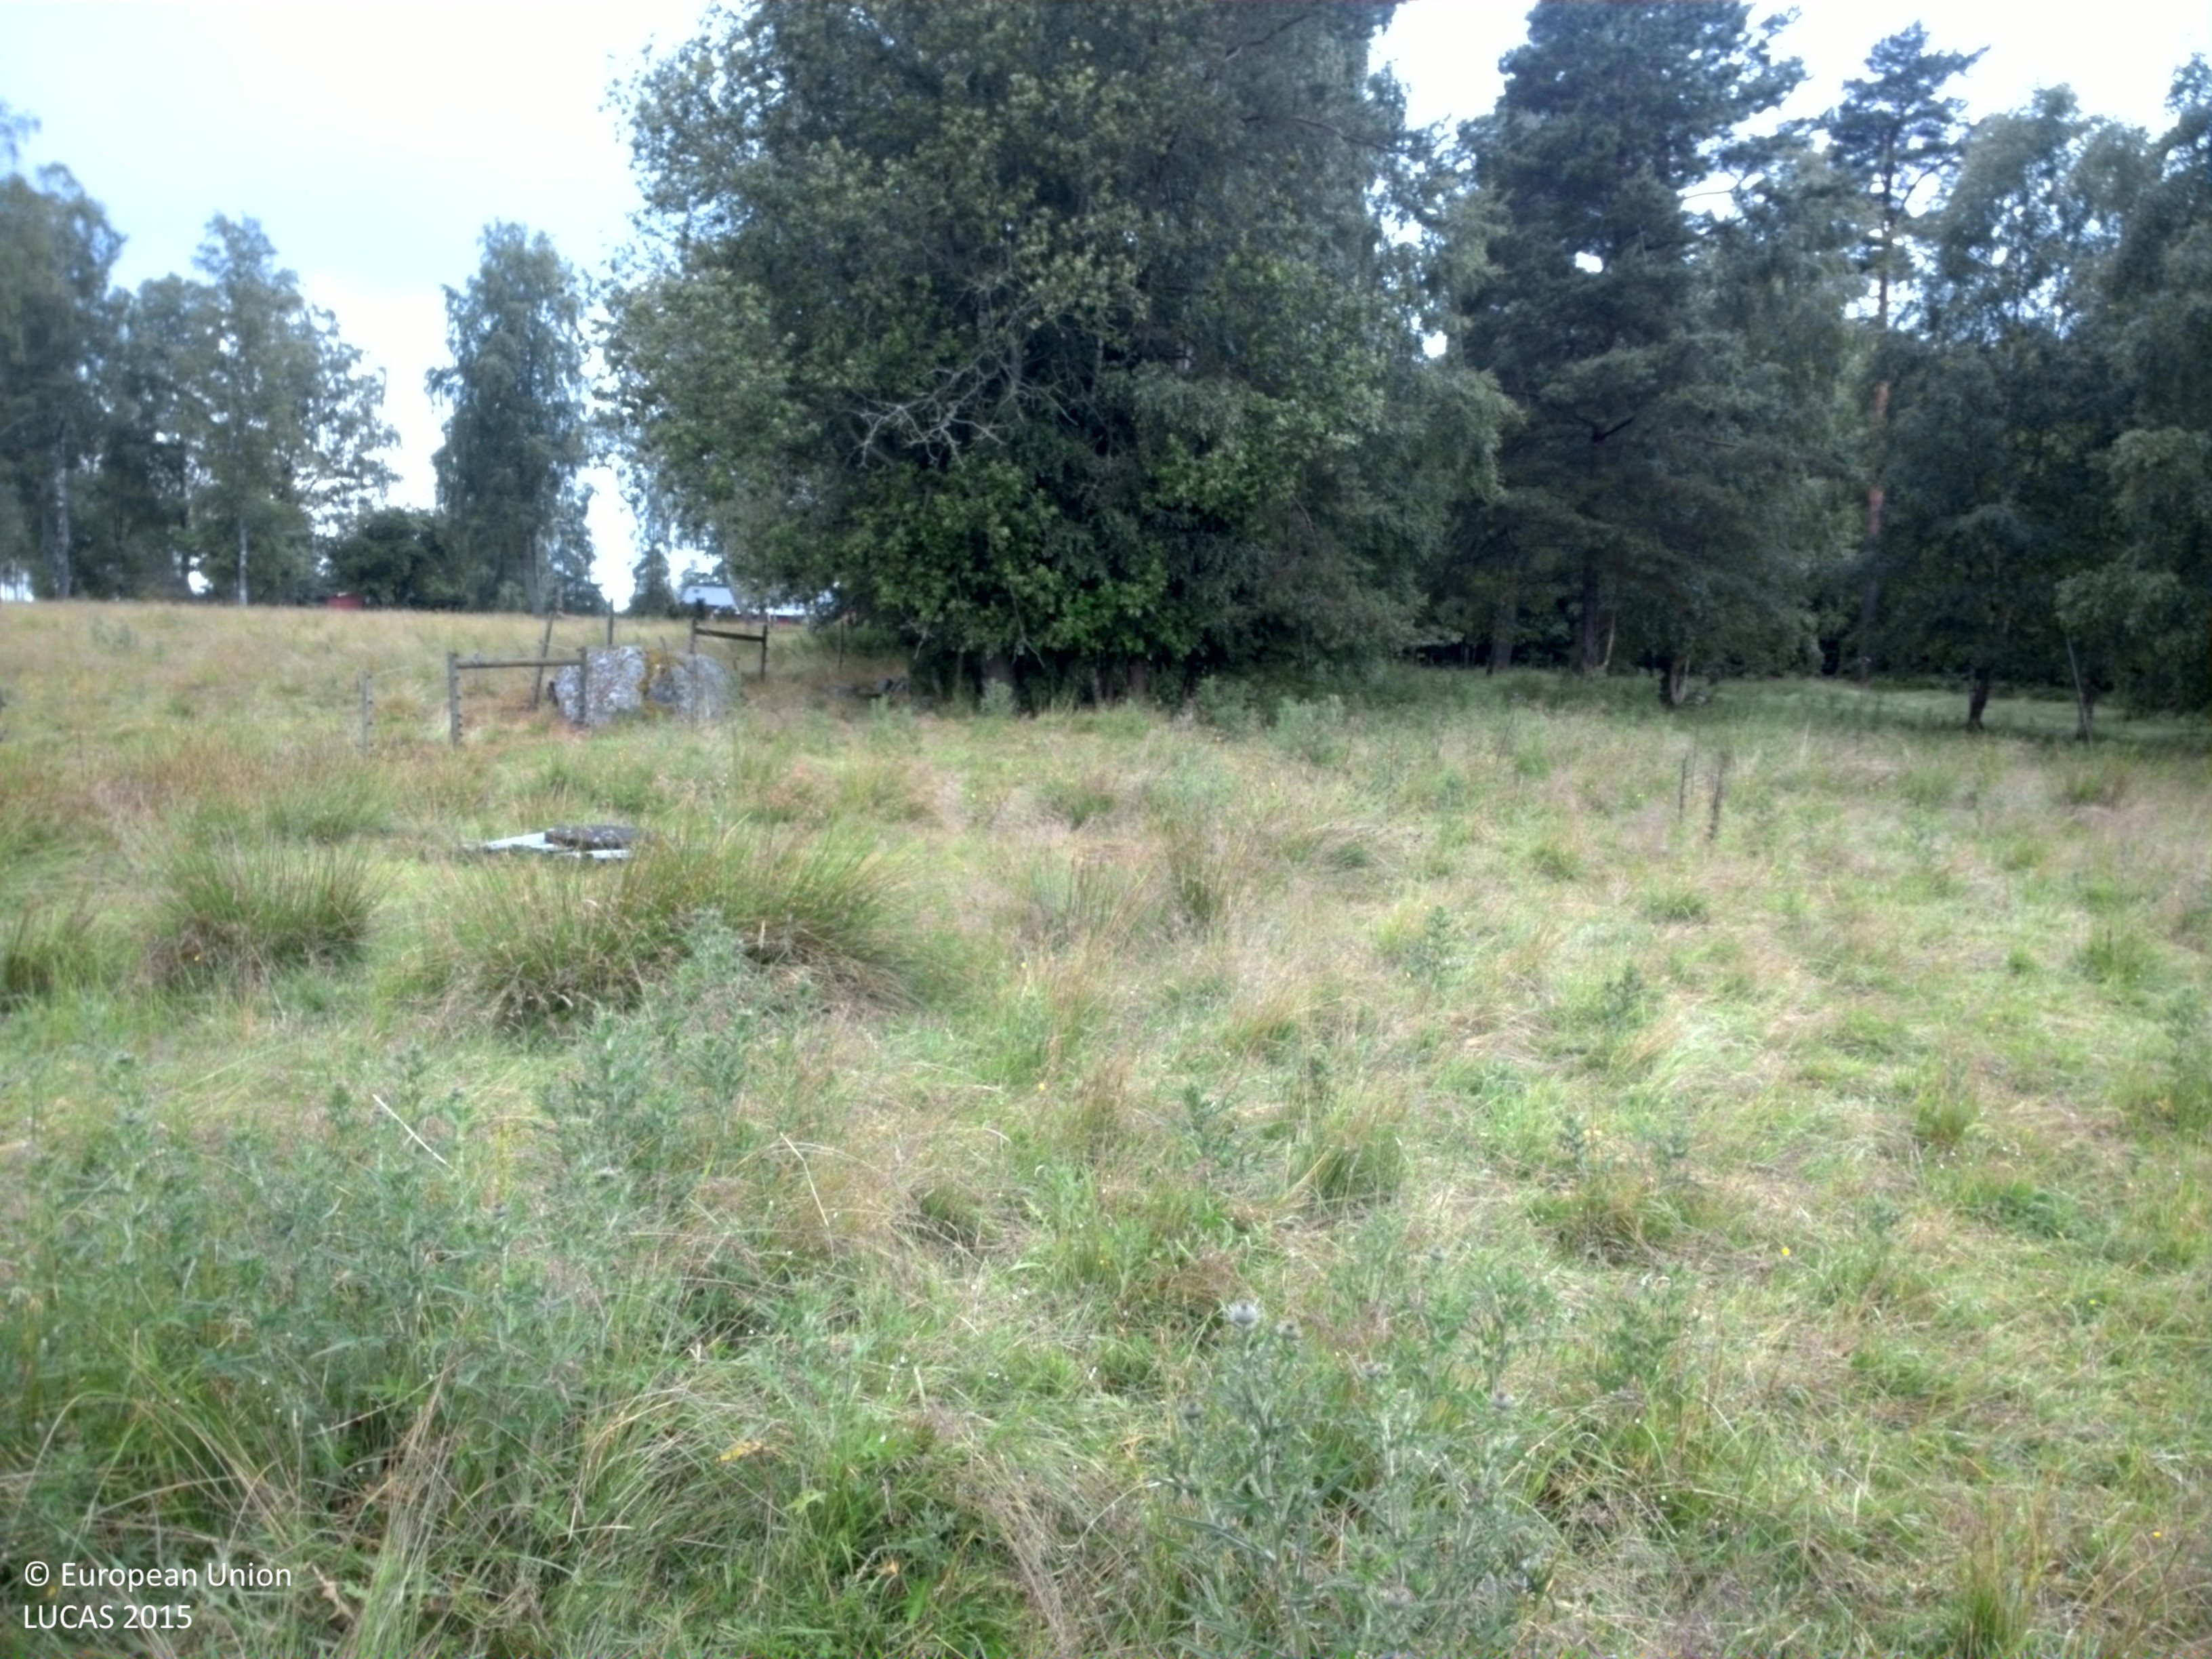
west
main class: Grassland
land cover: Grassland without tree/shrub cover
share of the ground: > 75 %
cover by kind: herbaceous plants 100 %
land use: Agriculture (excluding fallow land and kitchen gardens)
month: July
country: SE
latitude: 58.1963
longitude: 13.9921
